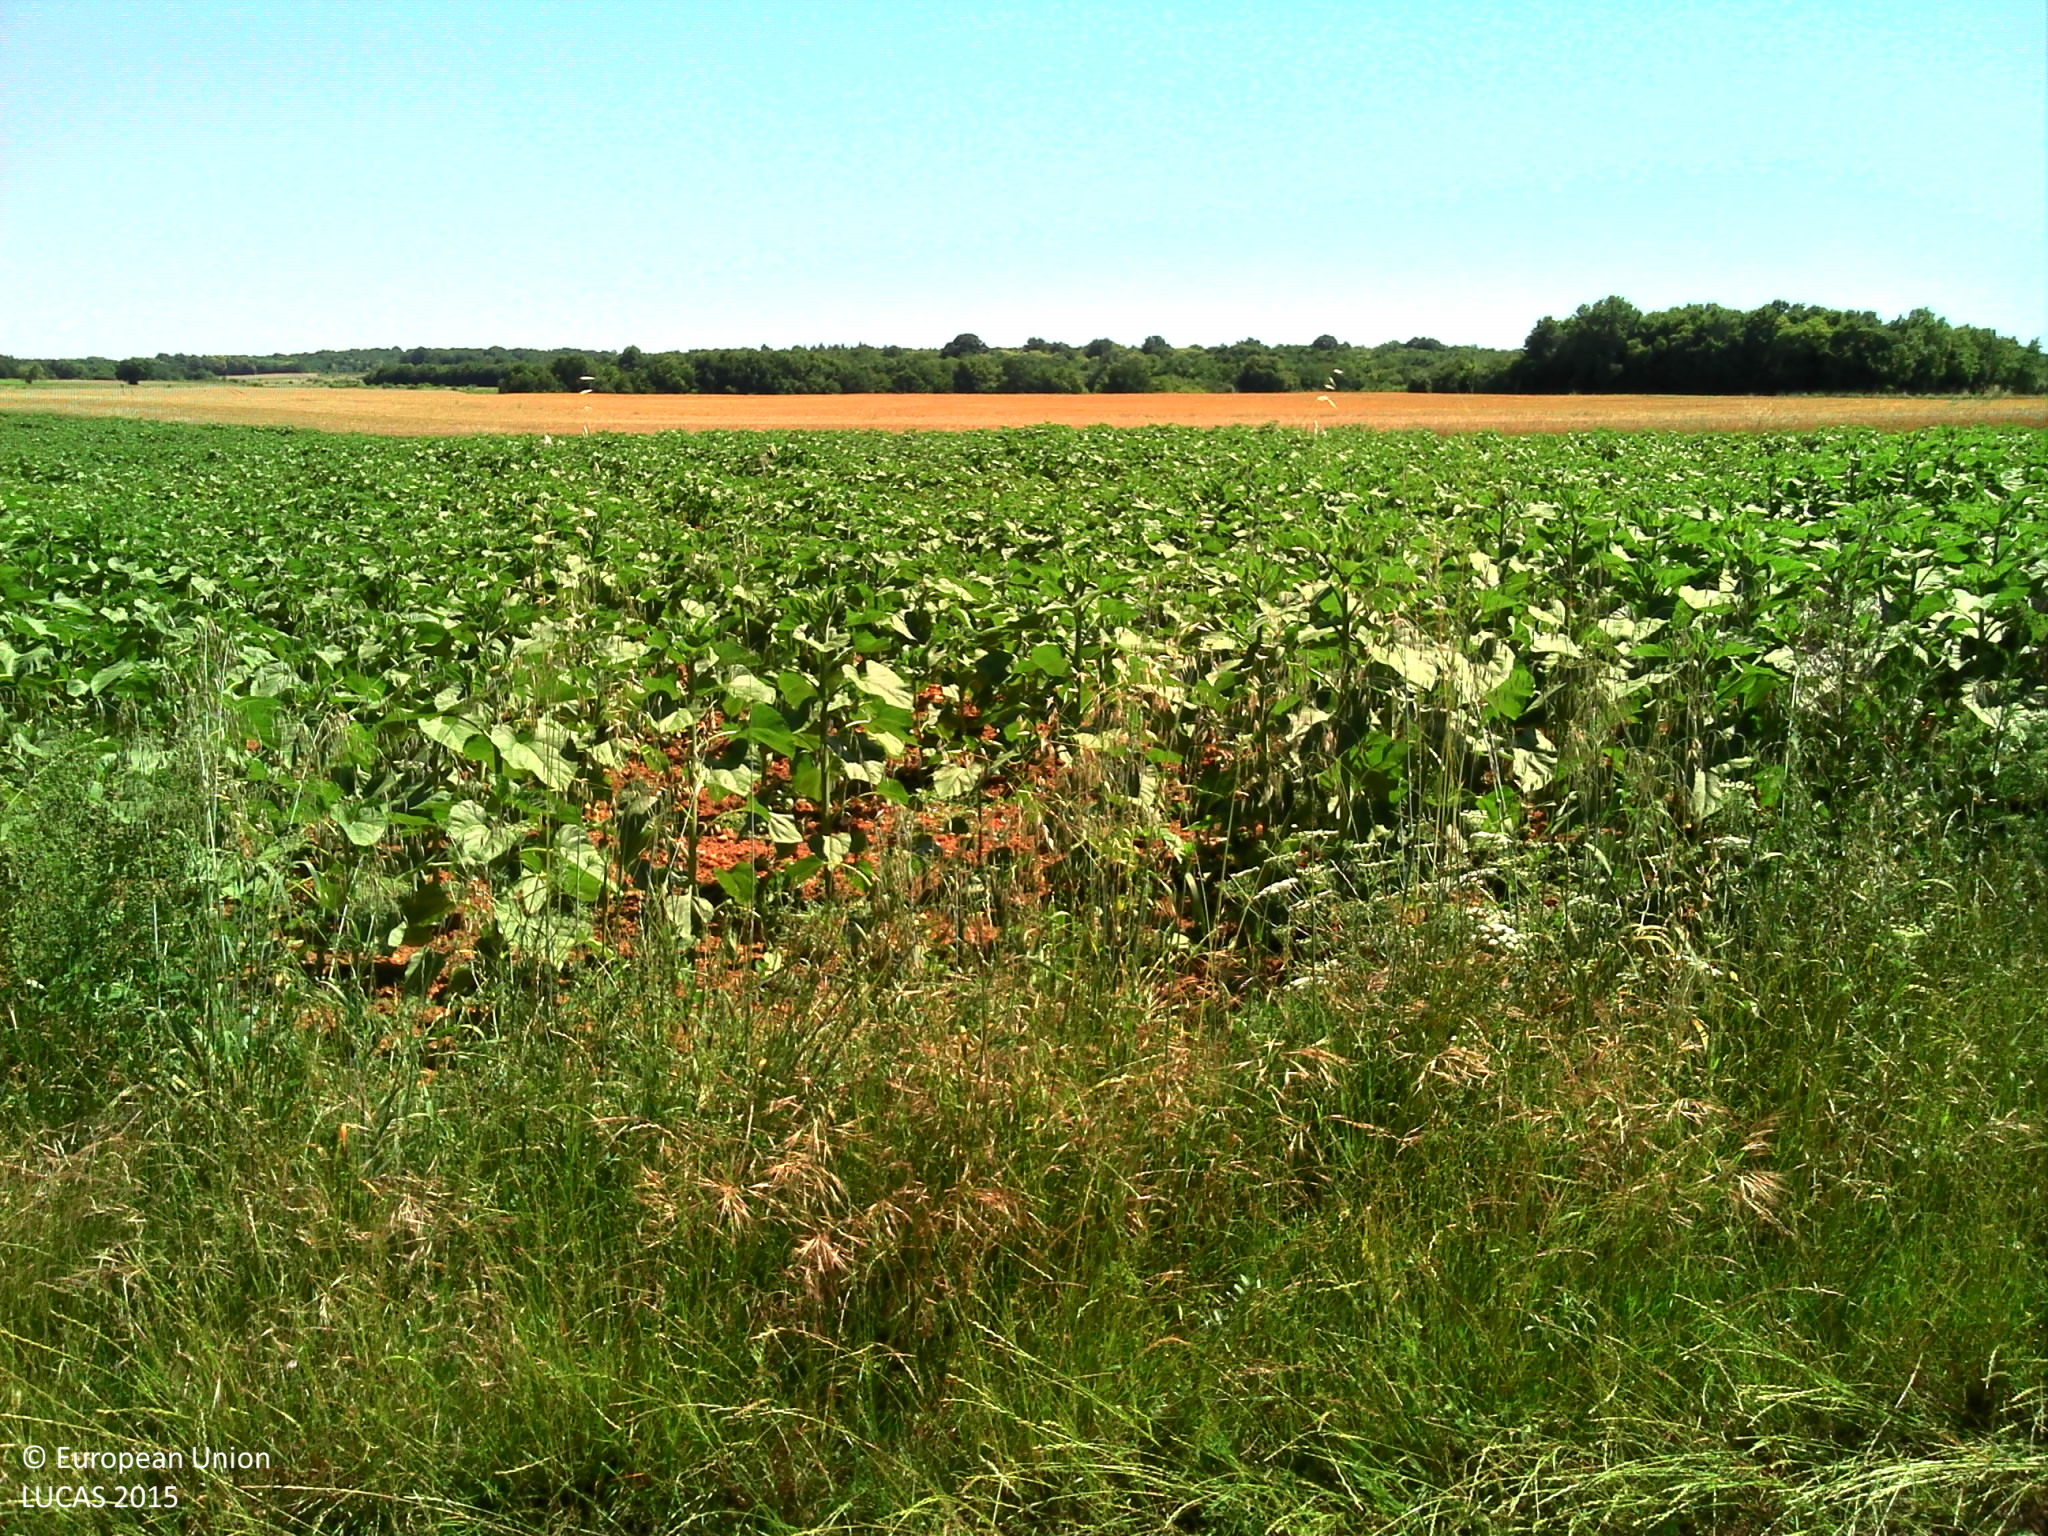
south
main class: Grassland
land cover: Grassland with sparse tree/shrub cover
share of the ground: > 75 %
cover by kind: herbaceous plants 95 %, coniferous forest trees 5 %
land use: Residential
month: June
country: FR
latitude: 45.8161
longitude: -0.6682
